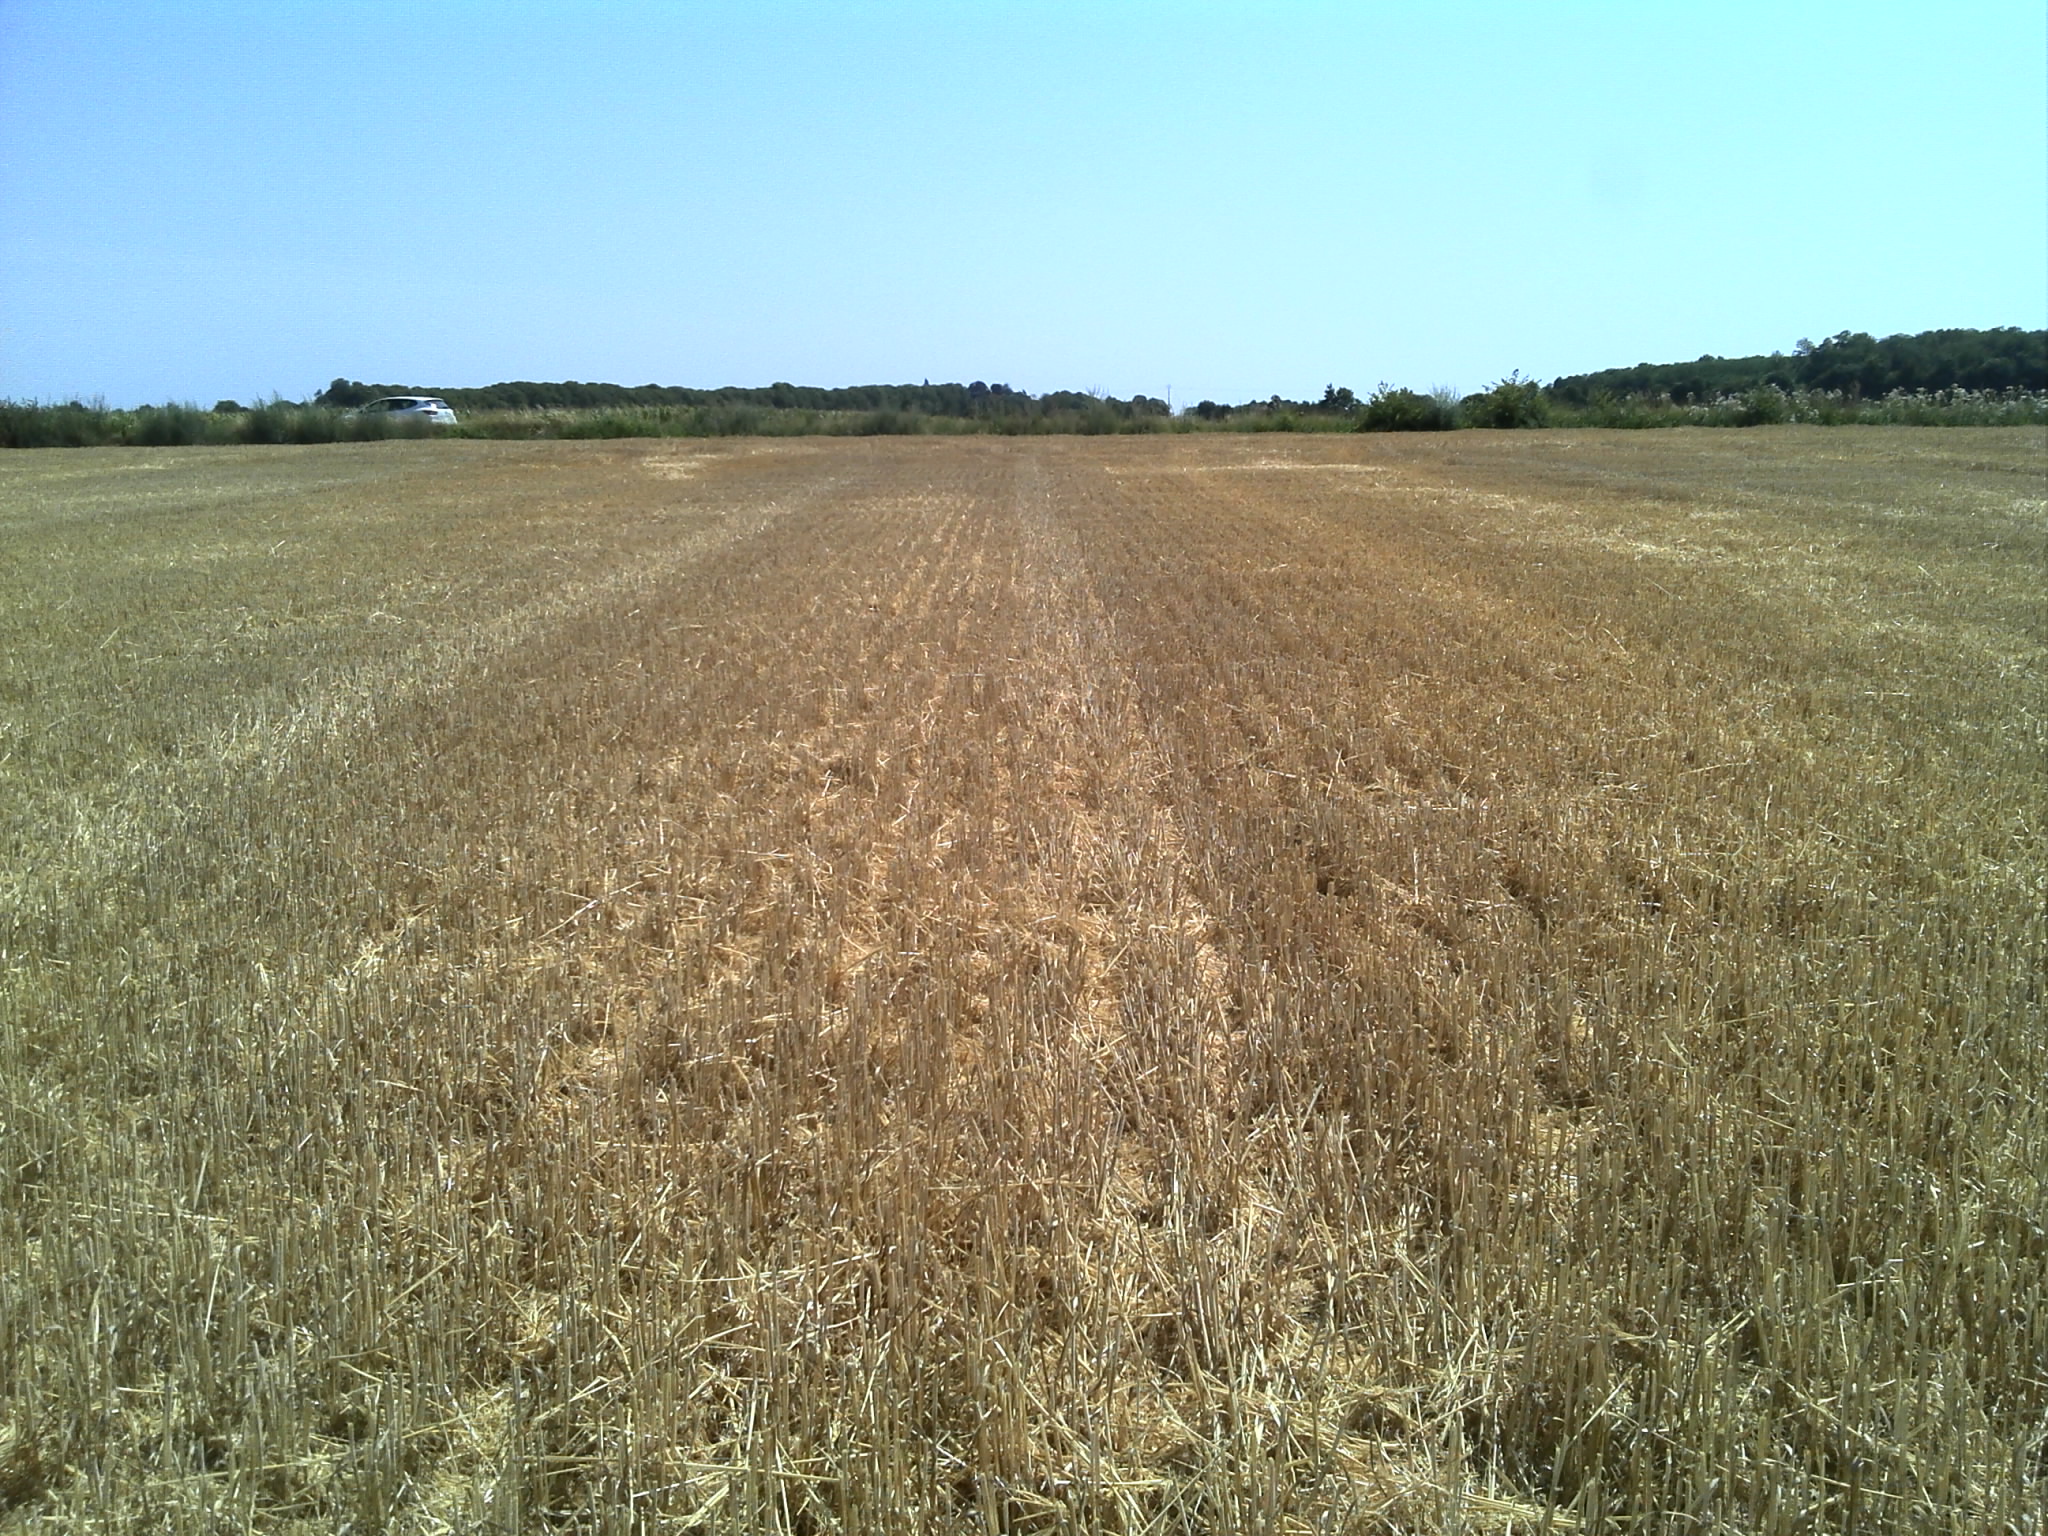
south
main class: Cropland
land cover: Durum wheat
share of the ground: 50 - 75 %
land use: Agriculture (excluding fallow land and kitchen gardens)
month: July
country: FR
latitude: 46.8792
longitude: 1.4722
